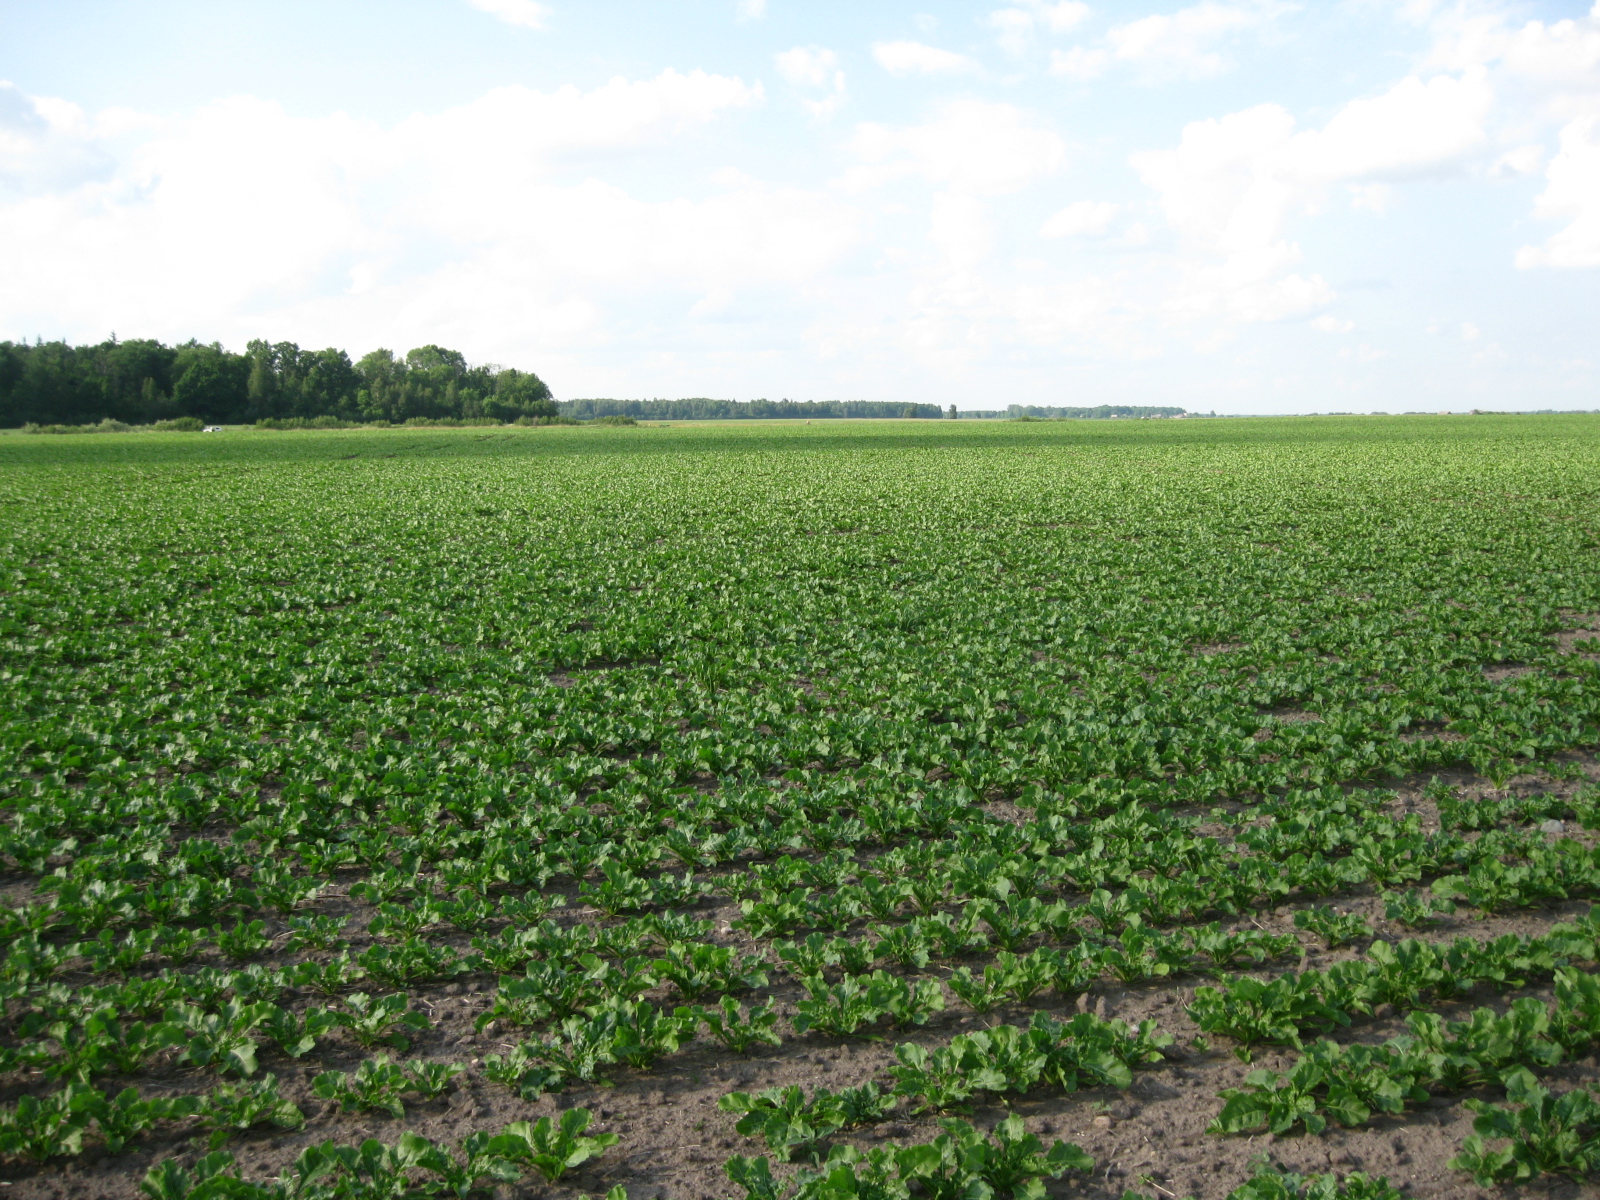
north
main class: Cropland
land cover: Sugar beet
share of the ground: 25 - 50 %
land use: Agriculture (excluding fallow land and kitchen gardens)
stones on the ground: < 10 %
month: June
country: LT
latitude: 55.5616
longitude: 23.8321
